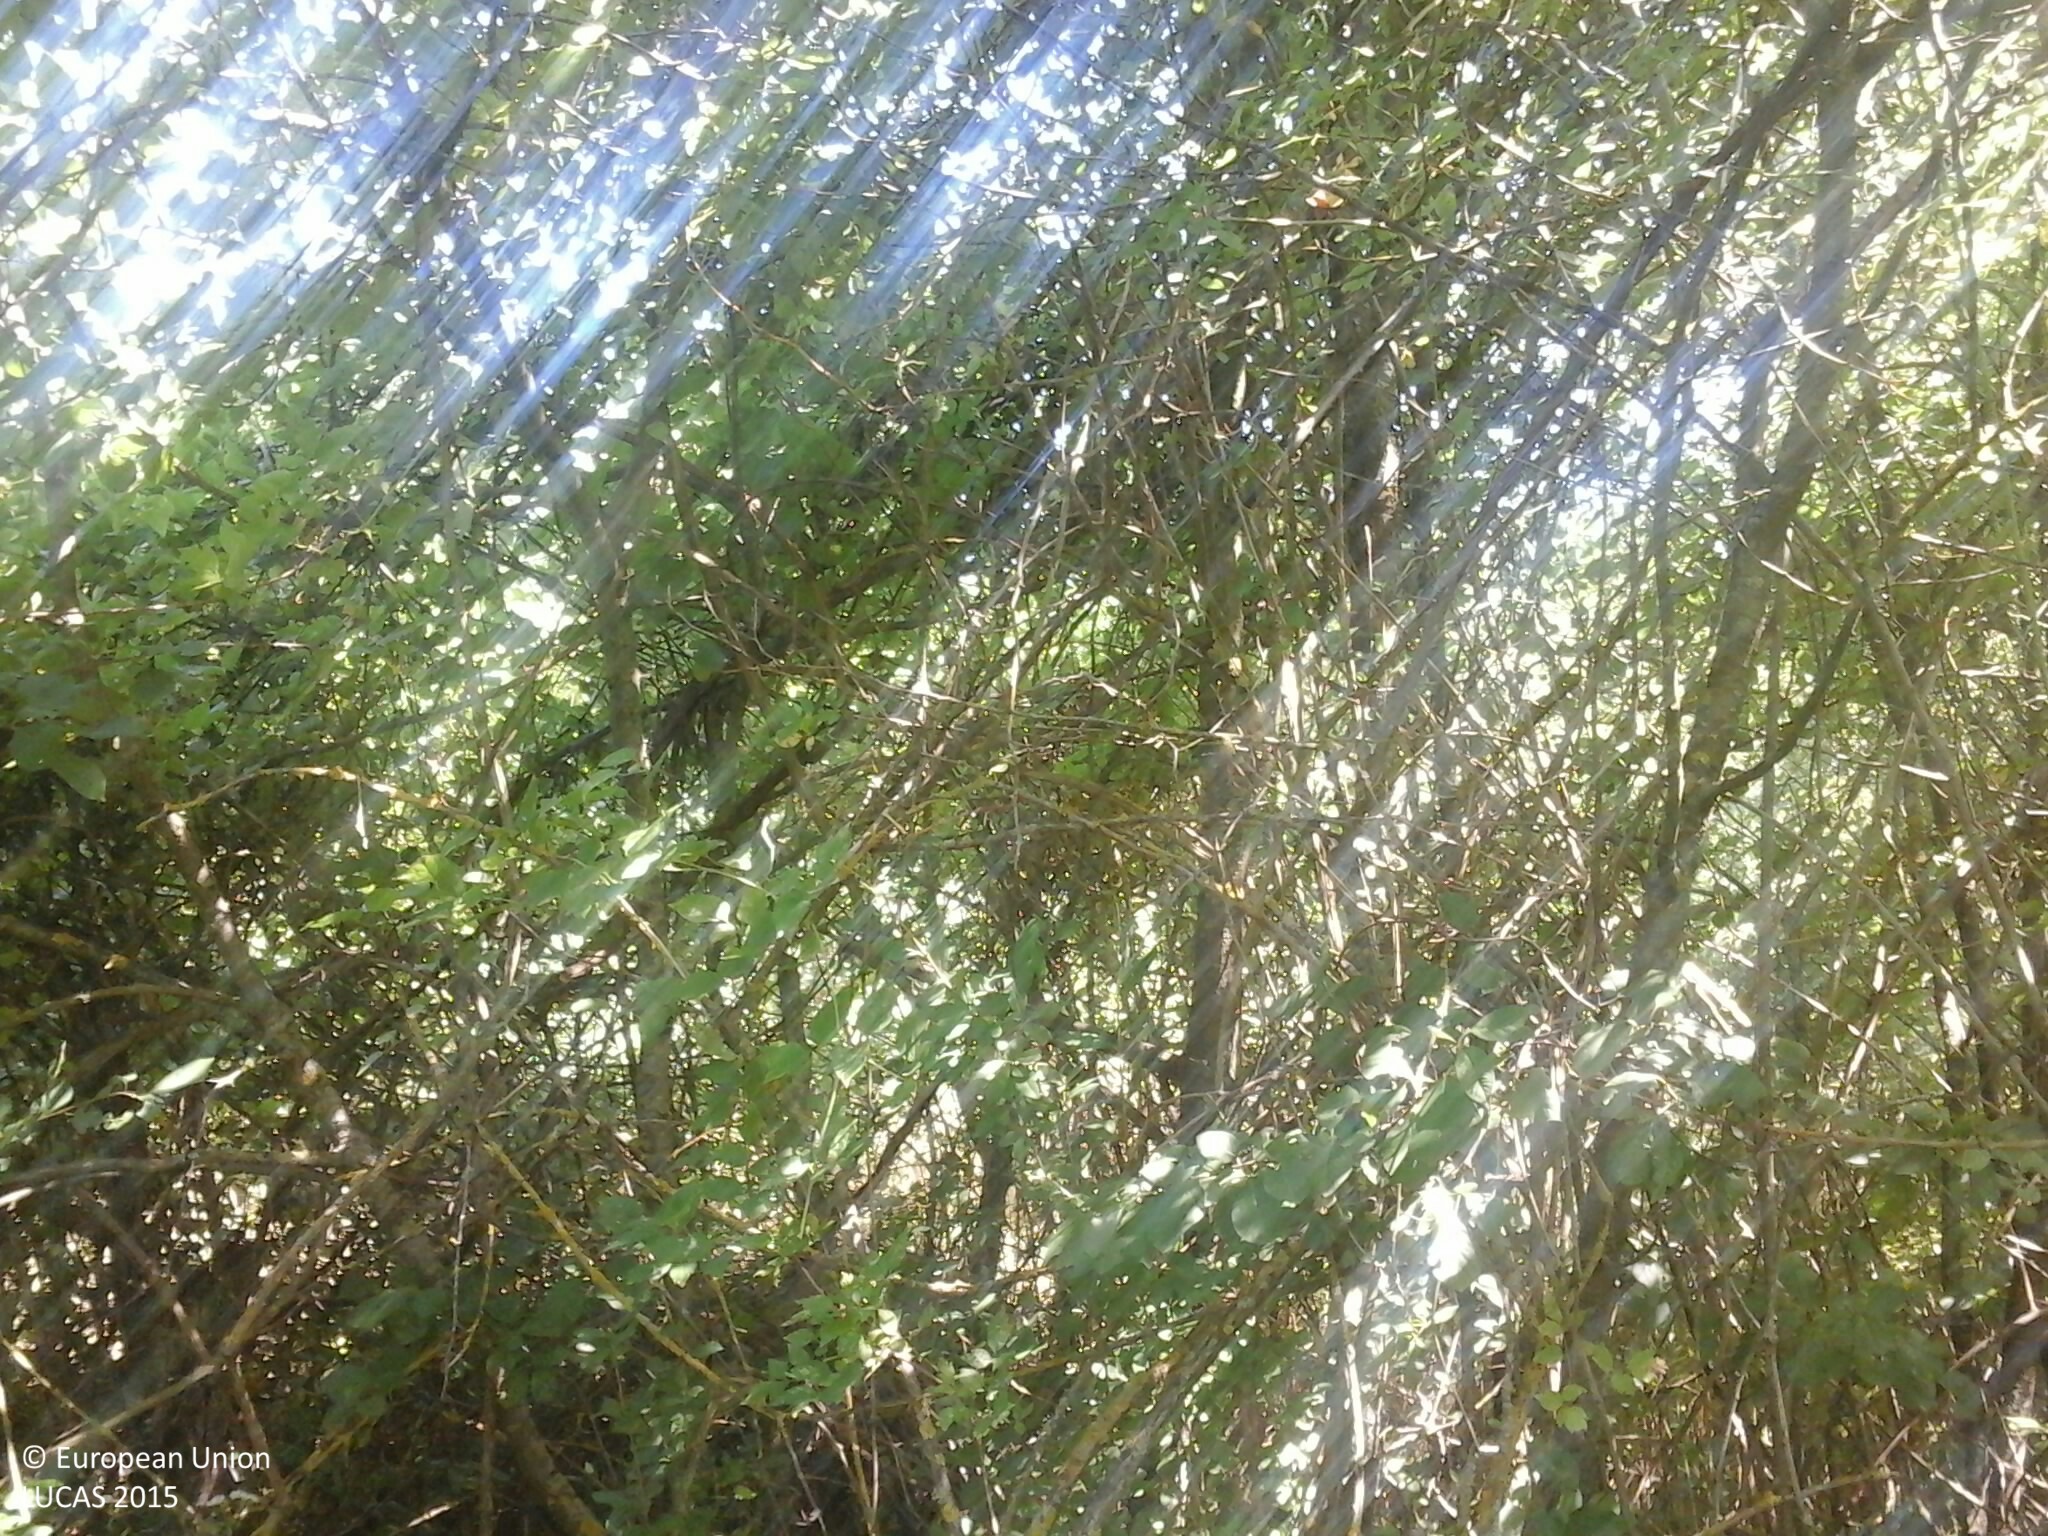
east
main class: Shrubland
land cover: Shrubland with sparse tree cover
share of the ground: > 75 %
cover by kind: shrubs 75 %, herbaceous plants 20 %, broadleaved forest trees 5 %
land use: Semi-natural and natural areas not in use
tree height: < 5 m
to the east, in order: Shrubland with sparse tree cover; Common wheat; Grass margins; Tracks; Grass margins; Broadleaved woodland; Lucerne; Fences; Grassland without tree/shrub cover; Fences; Tracks; Fences; Broadleaved woodland
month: August
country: HU
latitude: 46.7781
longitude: 17.9581
